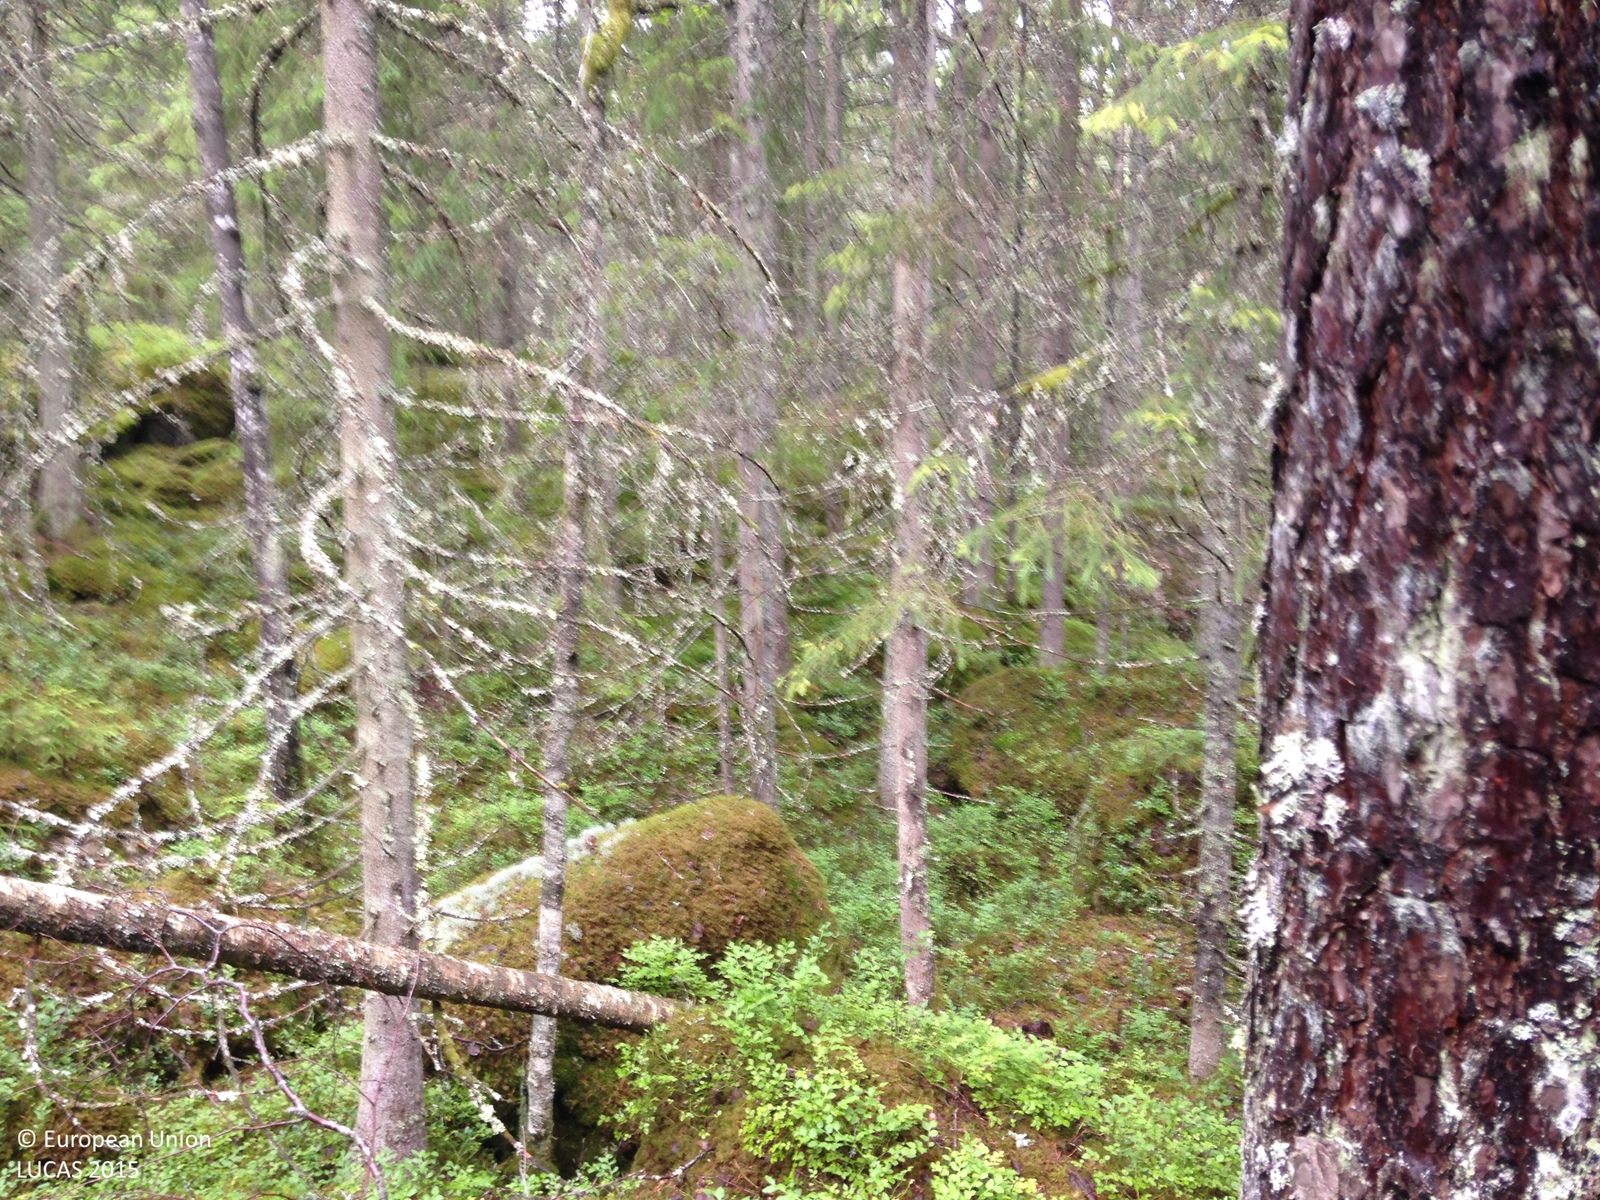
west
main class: Woodland
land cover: Other mixed woodland
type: boreal forest
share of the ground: 25 - 50 %
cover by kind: herbaceous plants 40 %, coniferous forest trees 25 %, lichens and mosses 20 %, broadleaved forest trees 15 %
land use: Amenities, museums, leisure
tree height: > 5 m
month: July
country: SE
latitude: 58.8824
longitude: 14.5205
